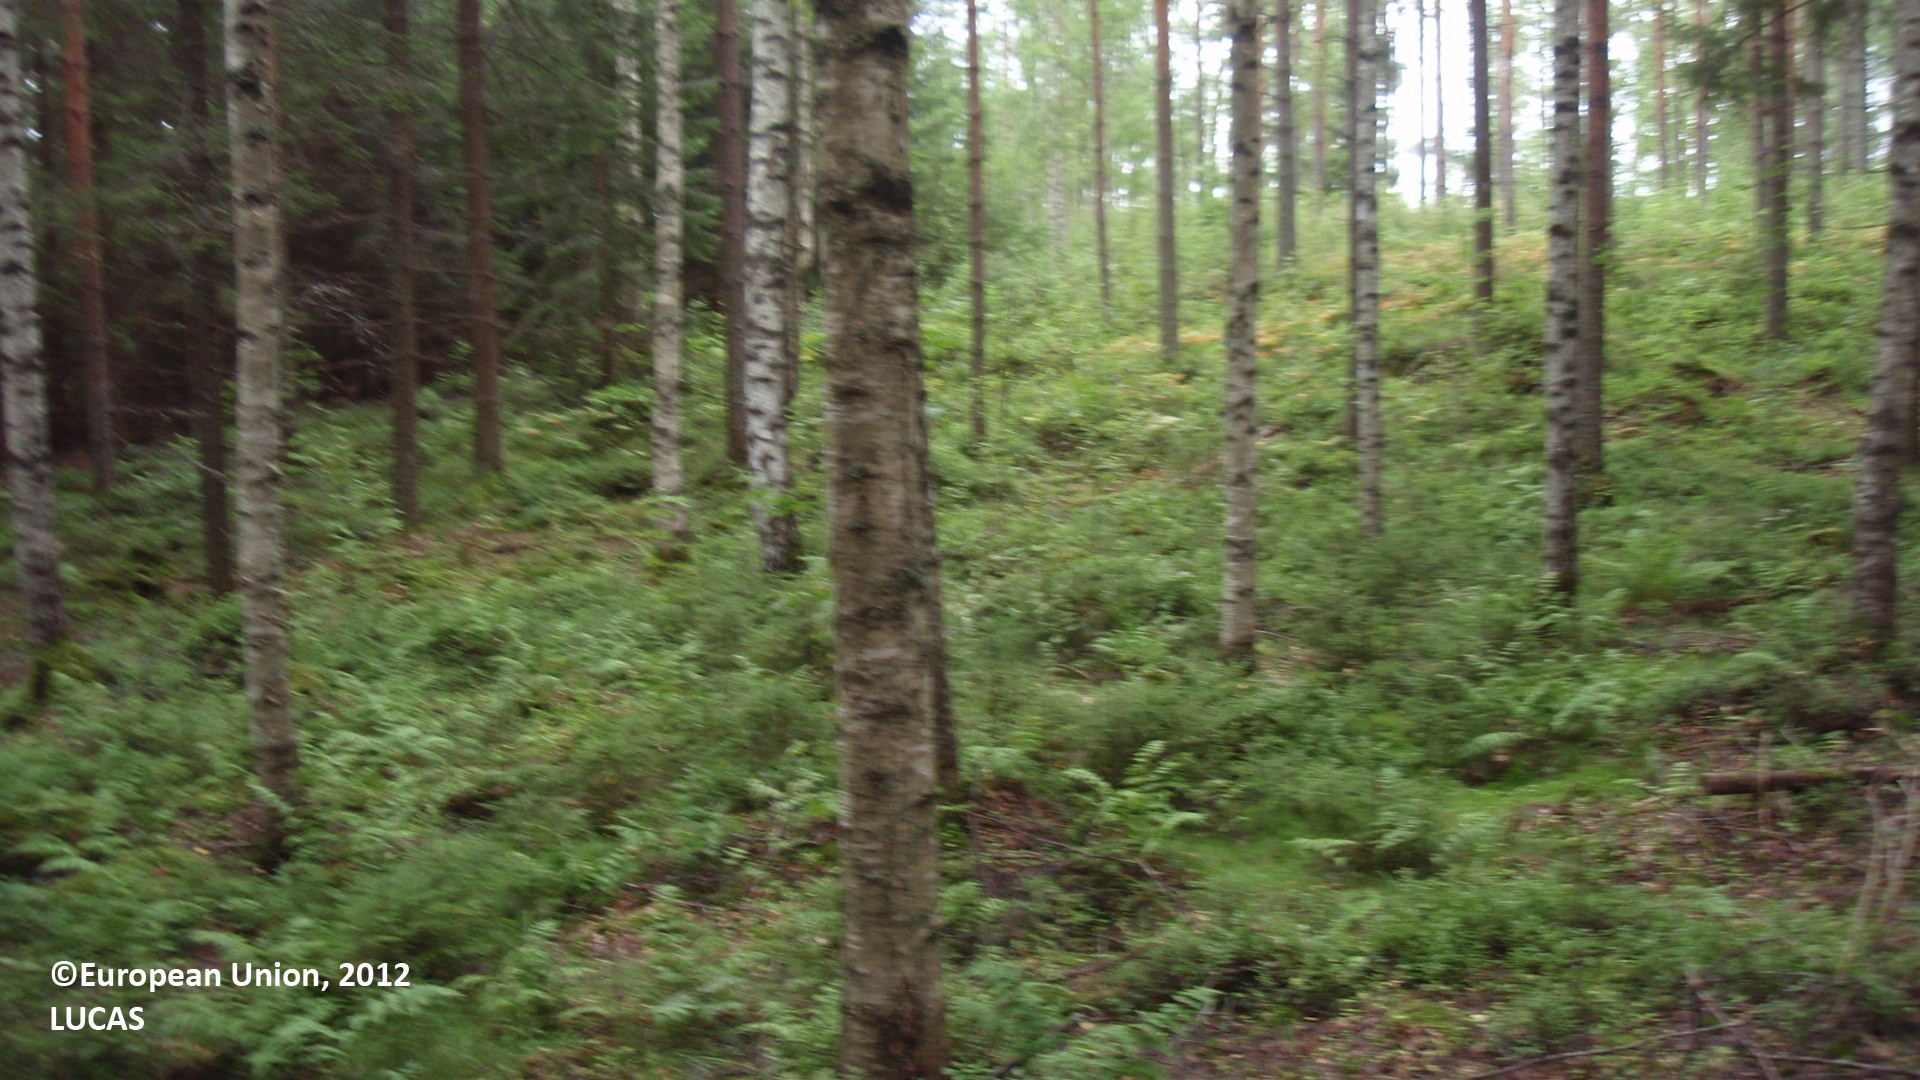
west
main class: Woodland
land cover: Spruce dominated mixed woodland
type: boreal forest
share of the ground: 50 - 75 %
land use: Forestry
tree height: > 5 m
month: August
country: FI
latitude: 61.1930
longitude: 27.7315
